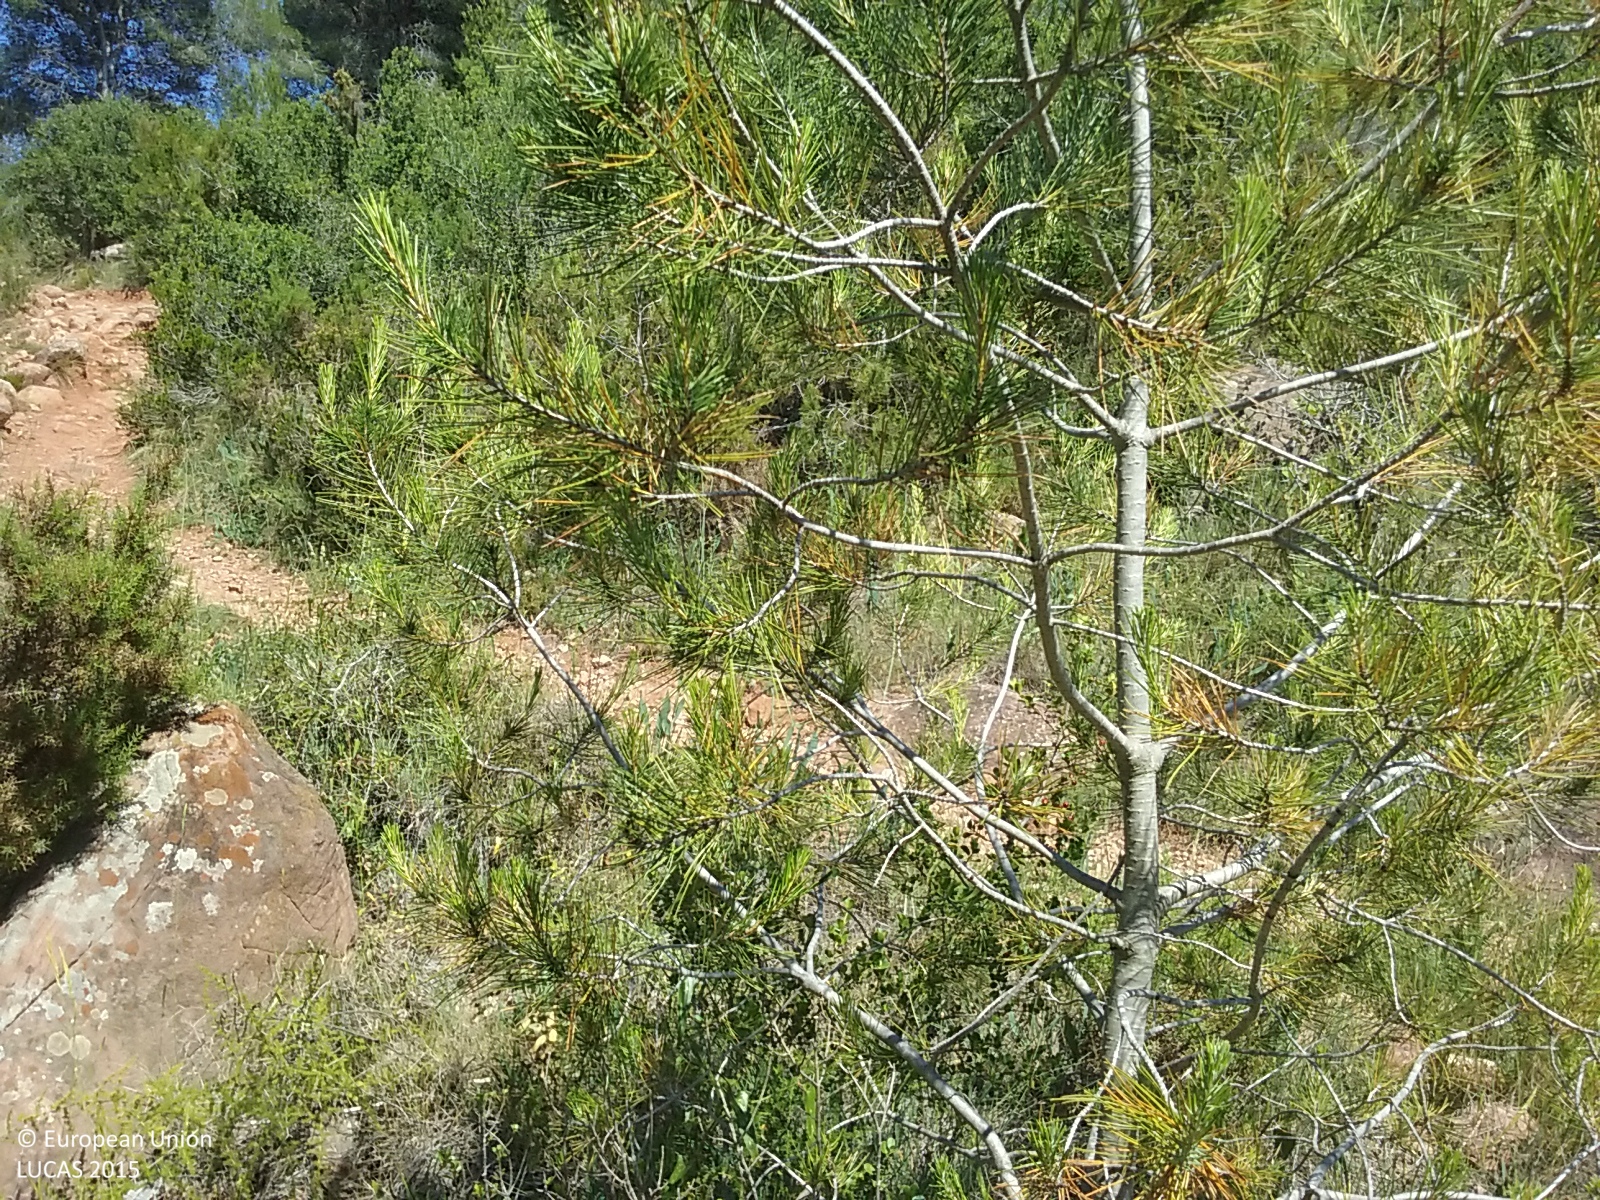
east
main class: Woodland
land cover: Pine dominated mixed woodland
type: coniferous forest of the mediterranean region
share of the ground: 50 - 75 %
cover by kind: coniferous forest trees 65 %, broadleaved forest trees 25 %, shrubs 10 %
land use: Semi-natural and natural areas not in use
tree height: > 5 m
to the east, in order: Pine dominated mixed woodland; Tracks; Pine dominated mixed woodland; Paved roads, cycling and walking lanes; Pine dominated mixed woodland; Dry stone walls; Nuts trees; Dry stone walls; Nuts trees; Pine dominated mixed woodland; Rivers and streams; Pine dominated mixed woodland; Other citrus fruit; Tracks
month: June
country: ES
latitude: 40.0467
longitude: 0.0004
